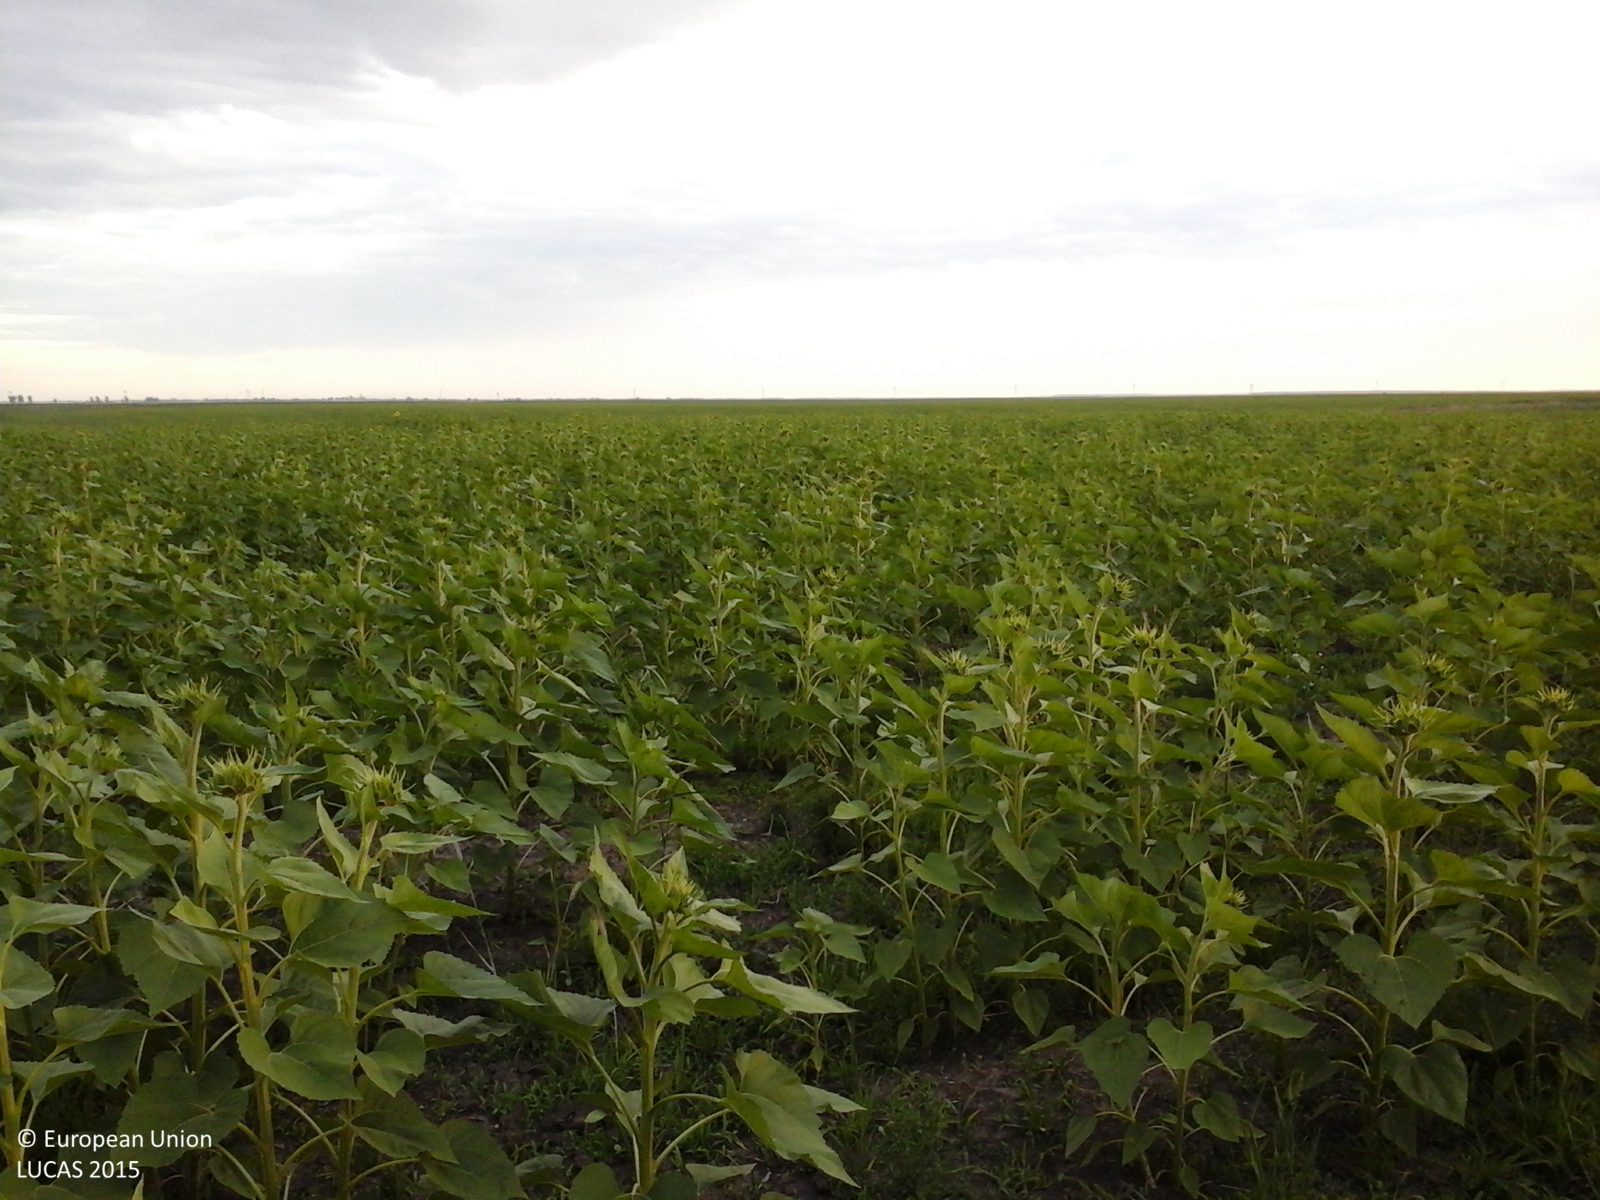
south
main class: Cropland
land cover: Sunflower
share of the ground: 50 - 75 %
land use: Agriculture (excluding fallow land and kitchen gardens)
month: July
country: RO
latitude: 44.3317
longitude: 24.8880
